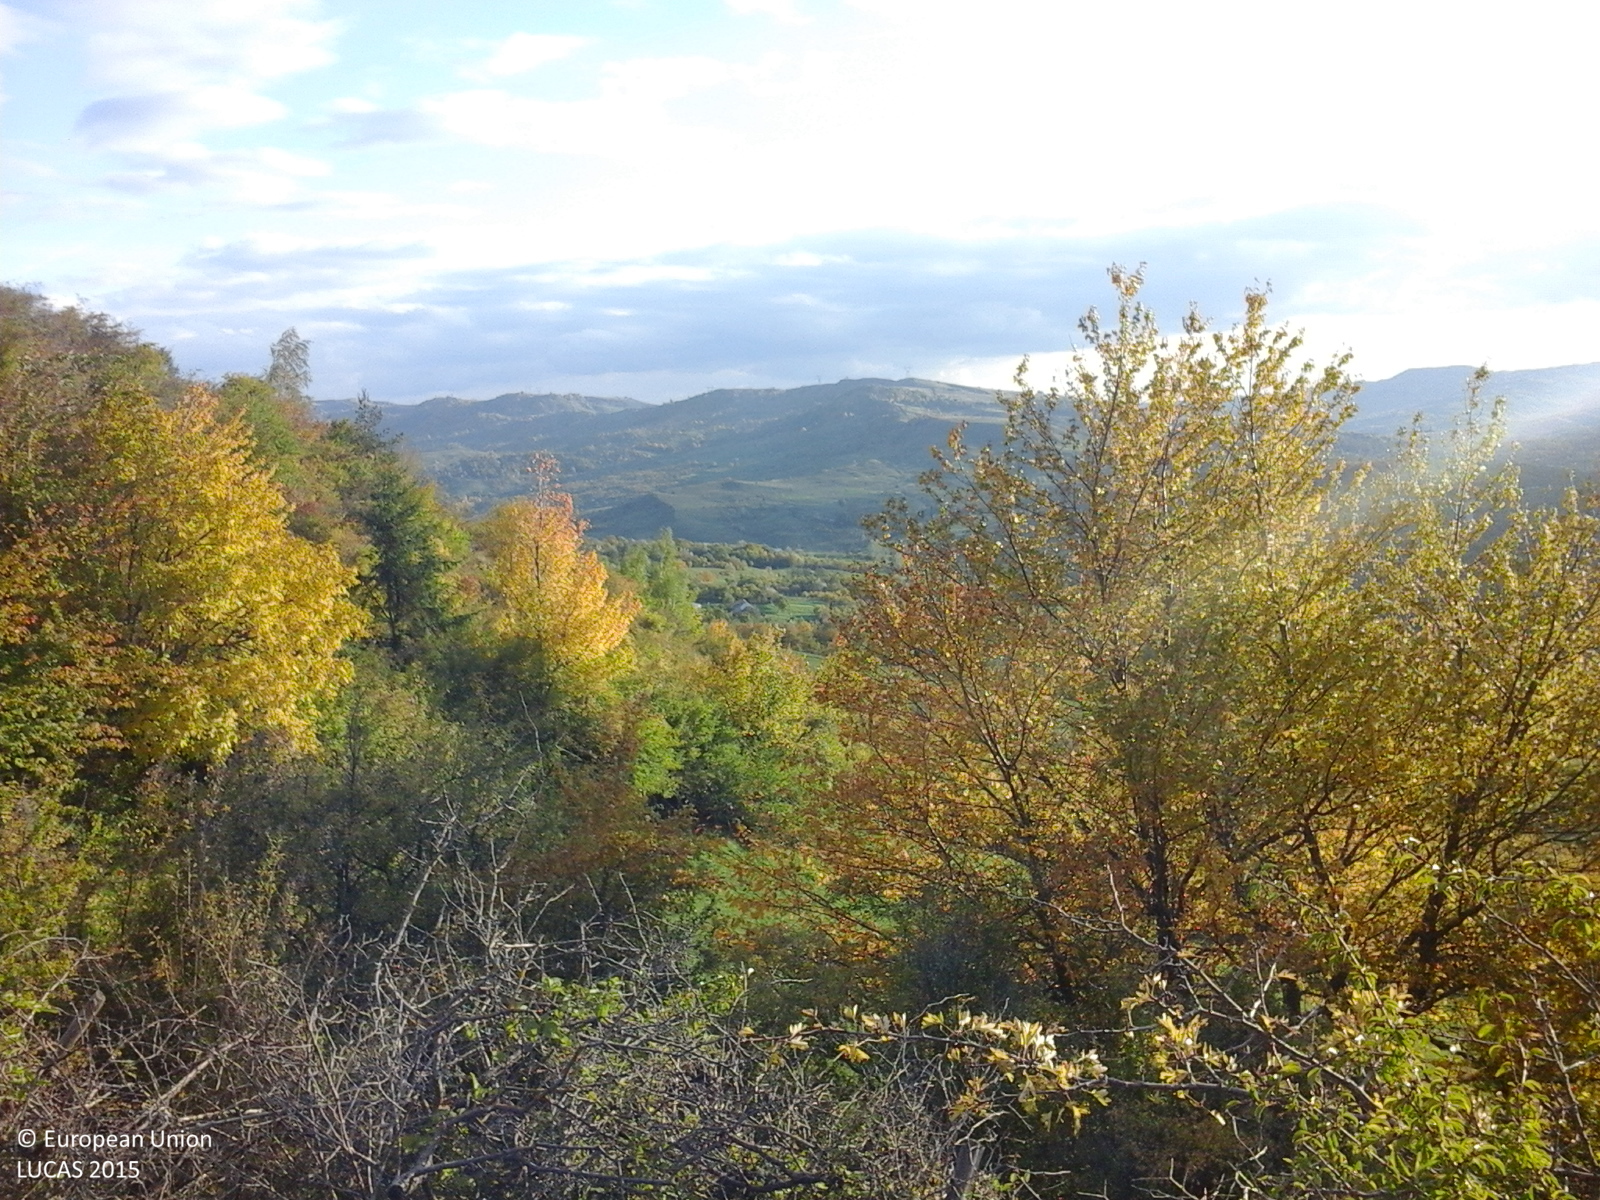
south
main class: Shrubland
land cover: Shrubland with sparse tree cover
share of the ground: > 75 %
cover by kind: shrubs 85 %, herbaceous plants 10 %, broadleaved forest trees 5 %
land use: Semi-natural and natural areas not in use
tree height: < 5 m
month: October
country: RO
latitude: 45.2829
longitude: 25.1474
